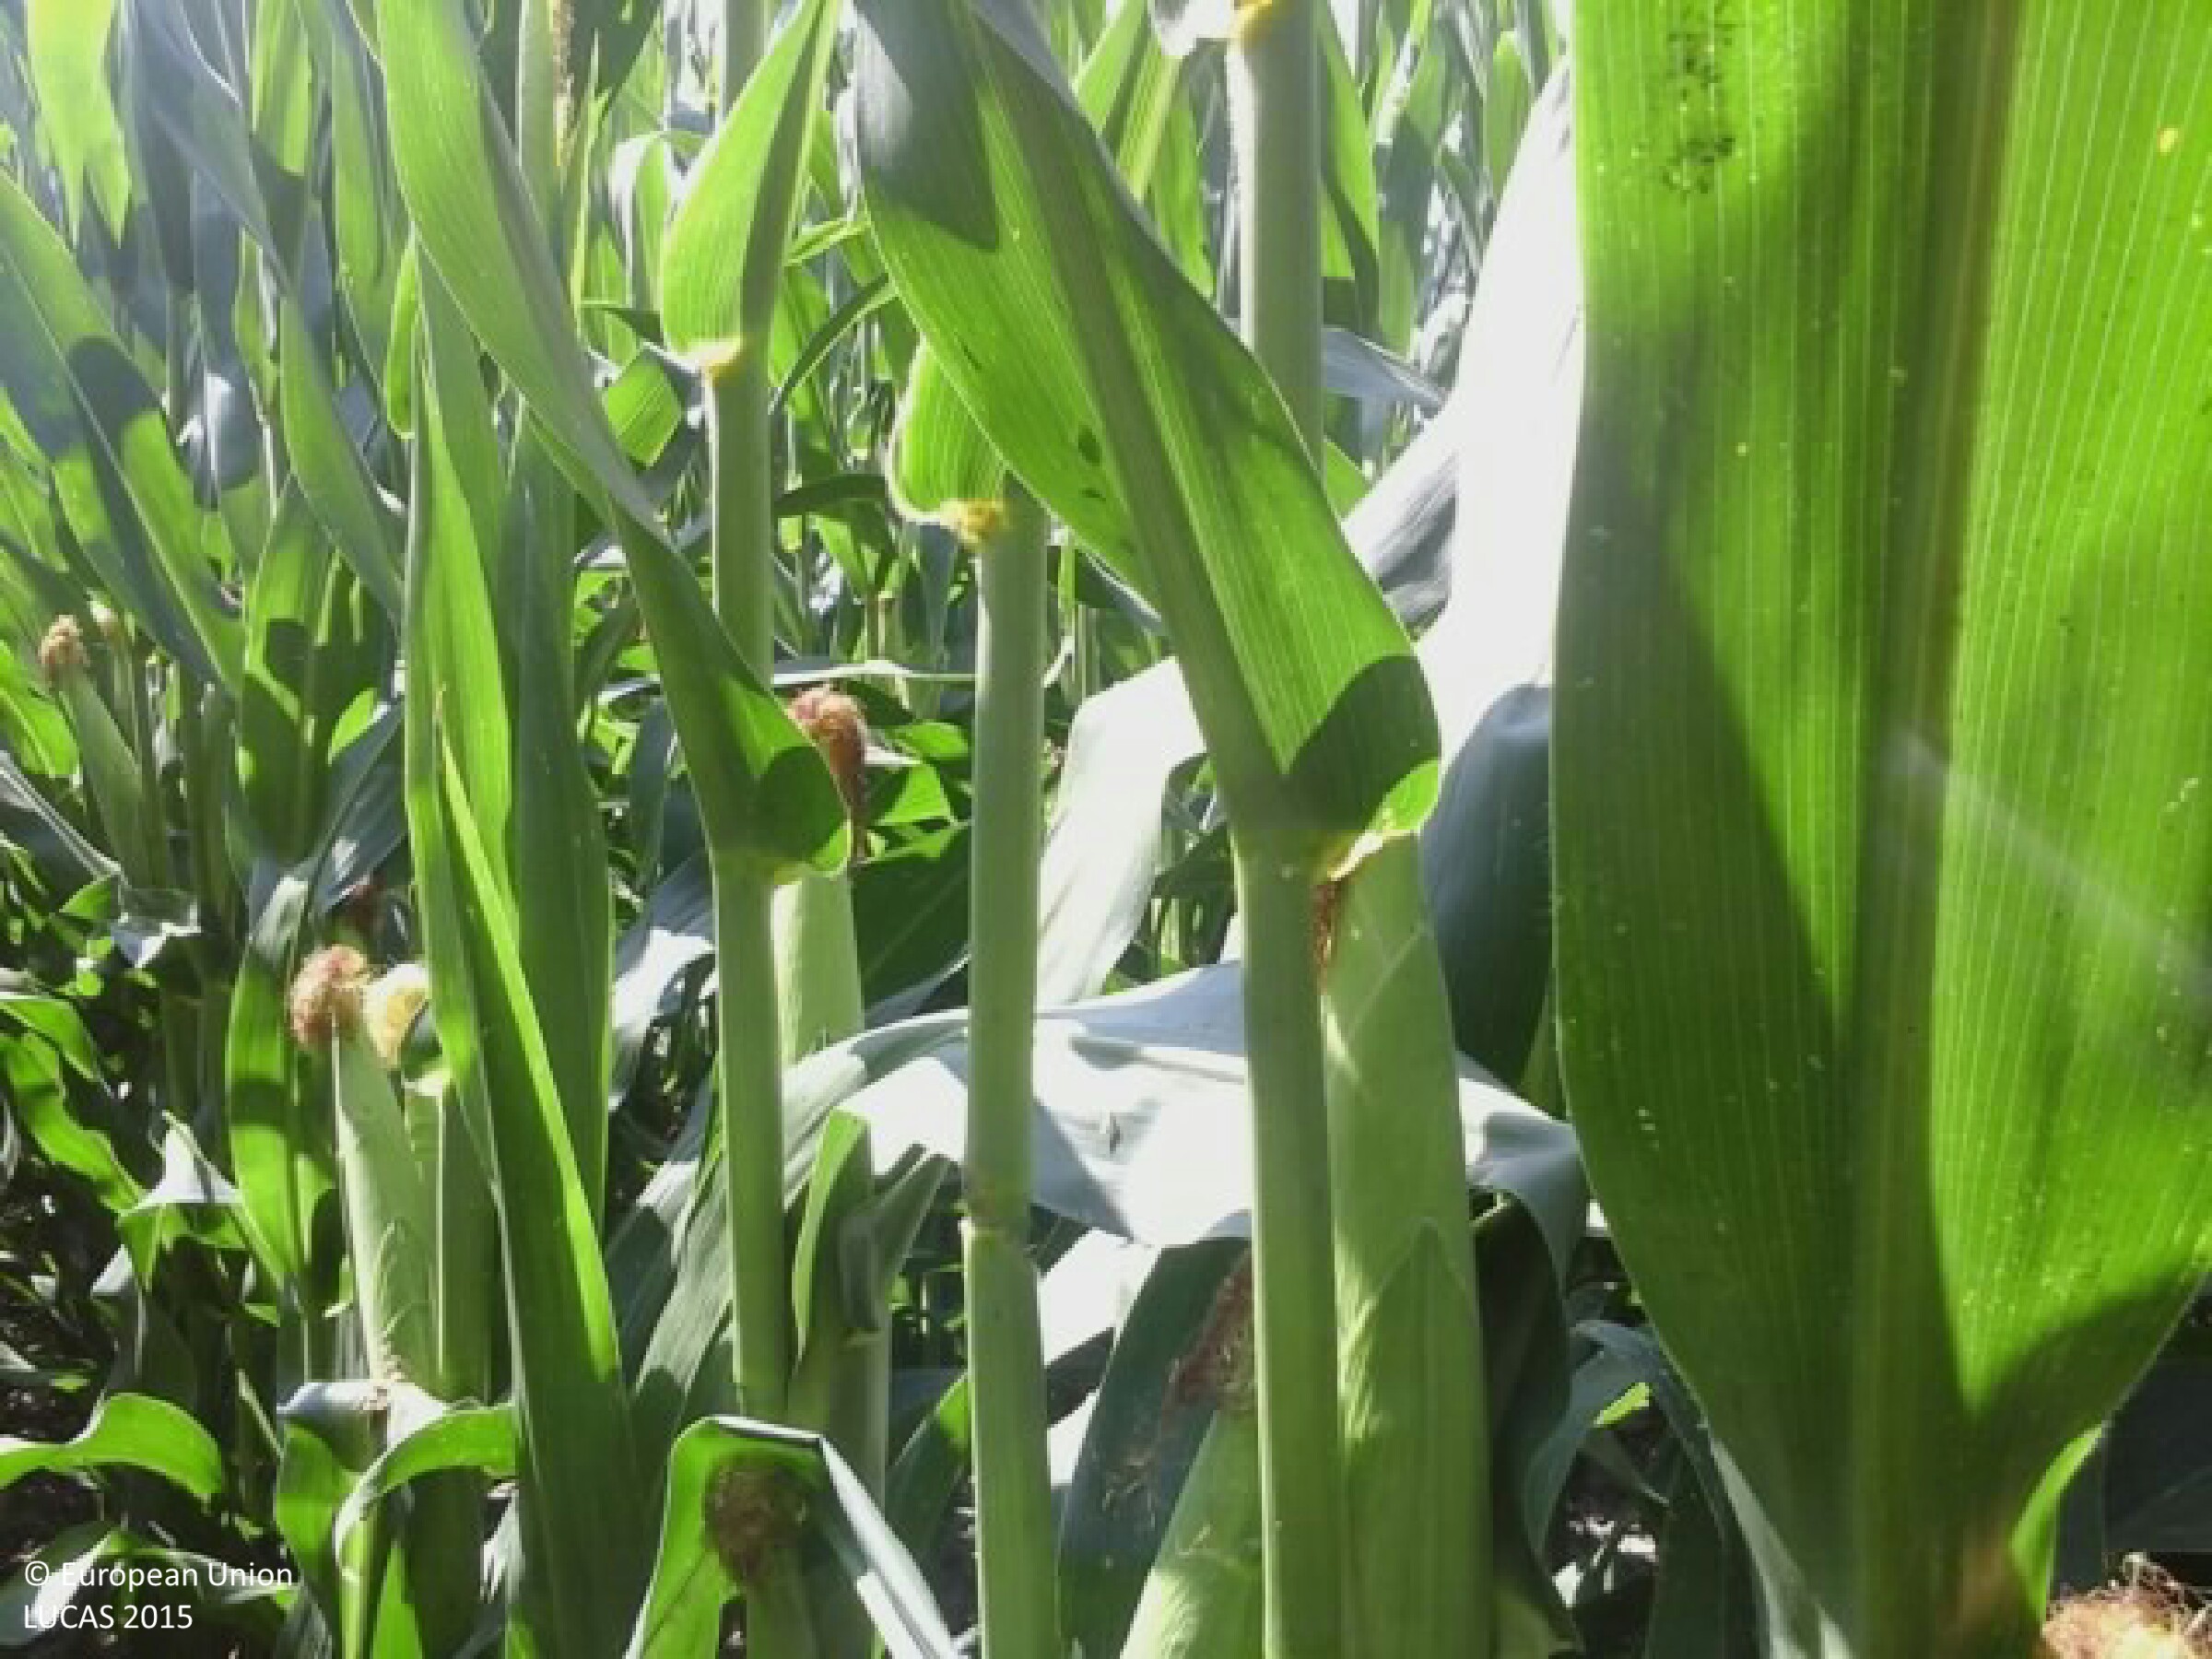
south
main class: Cropland
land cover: Maize
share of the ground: > 75 %
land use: Agriculture (excluding fallow land and kitchen gardens)
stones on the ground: < 10 %
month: July
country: HU
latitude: 46.4703
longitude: 18.8815
